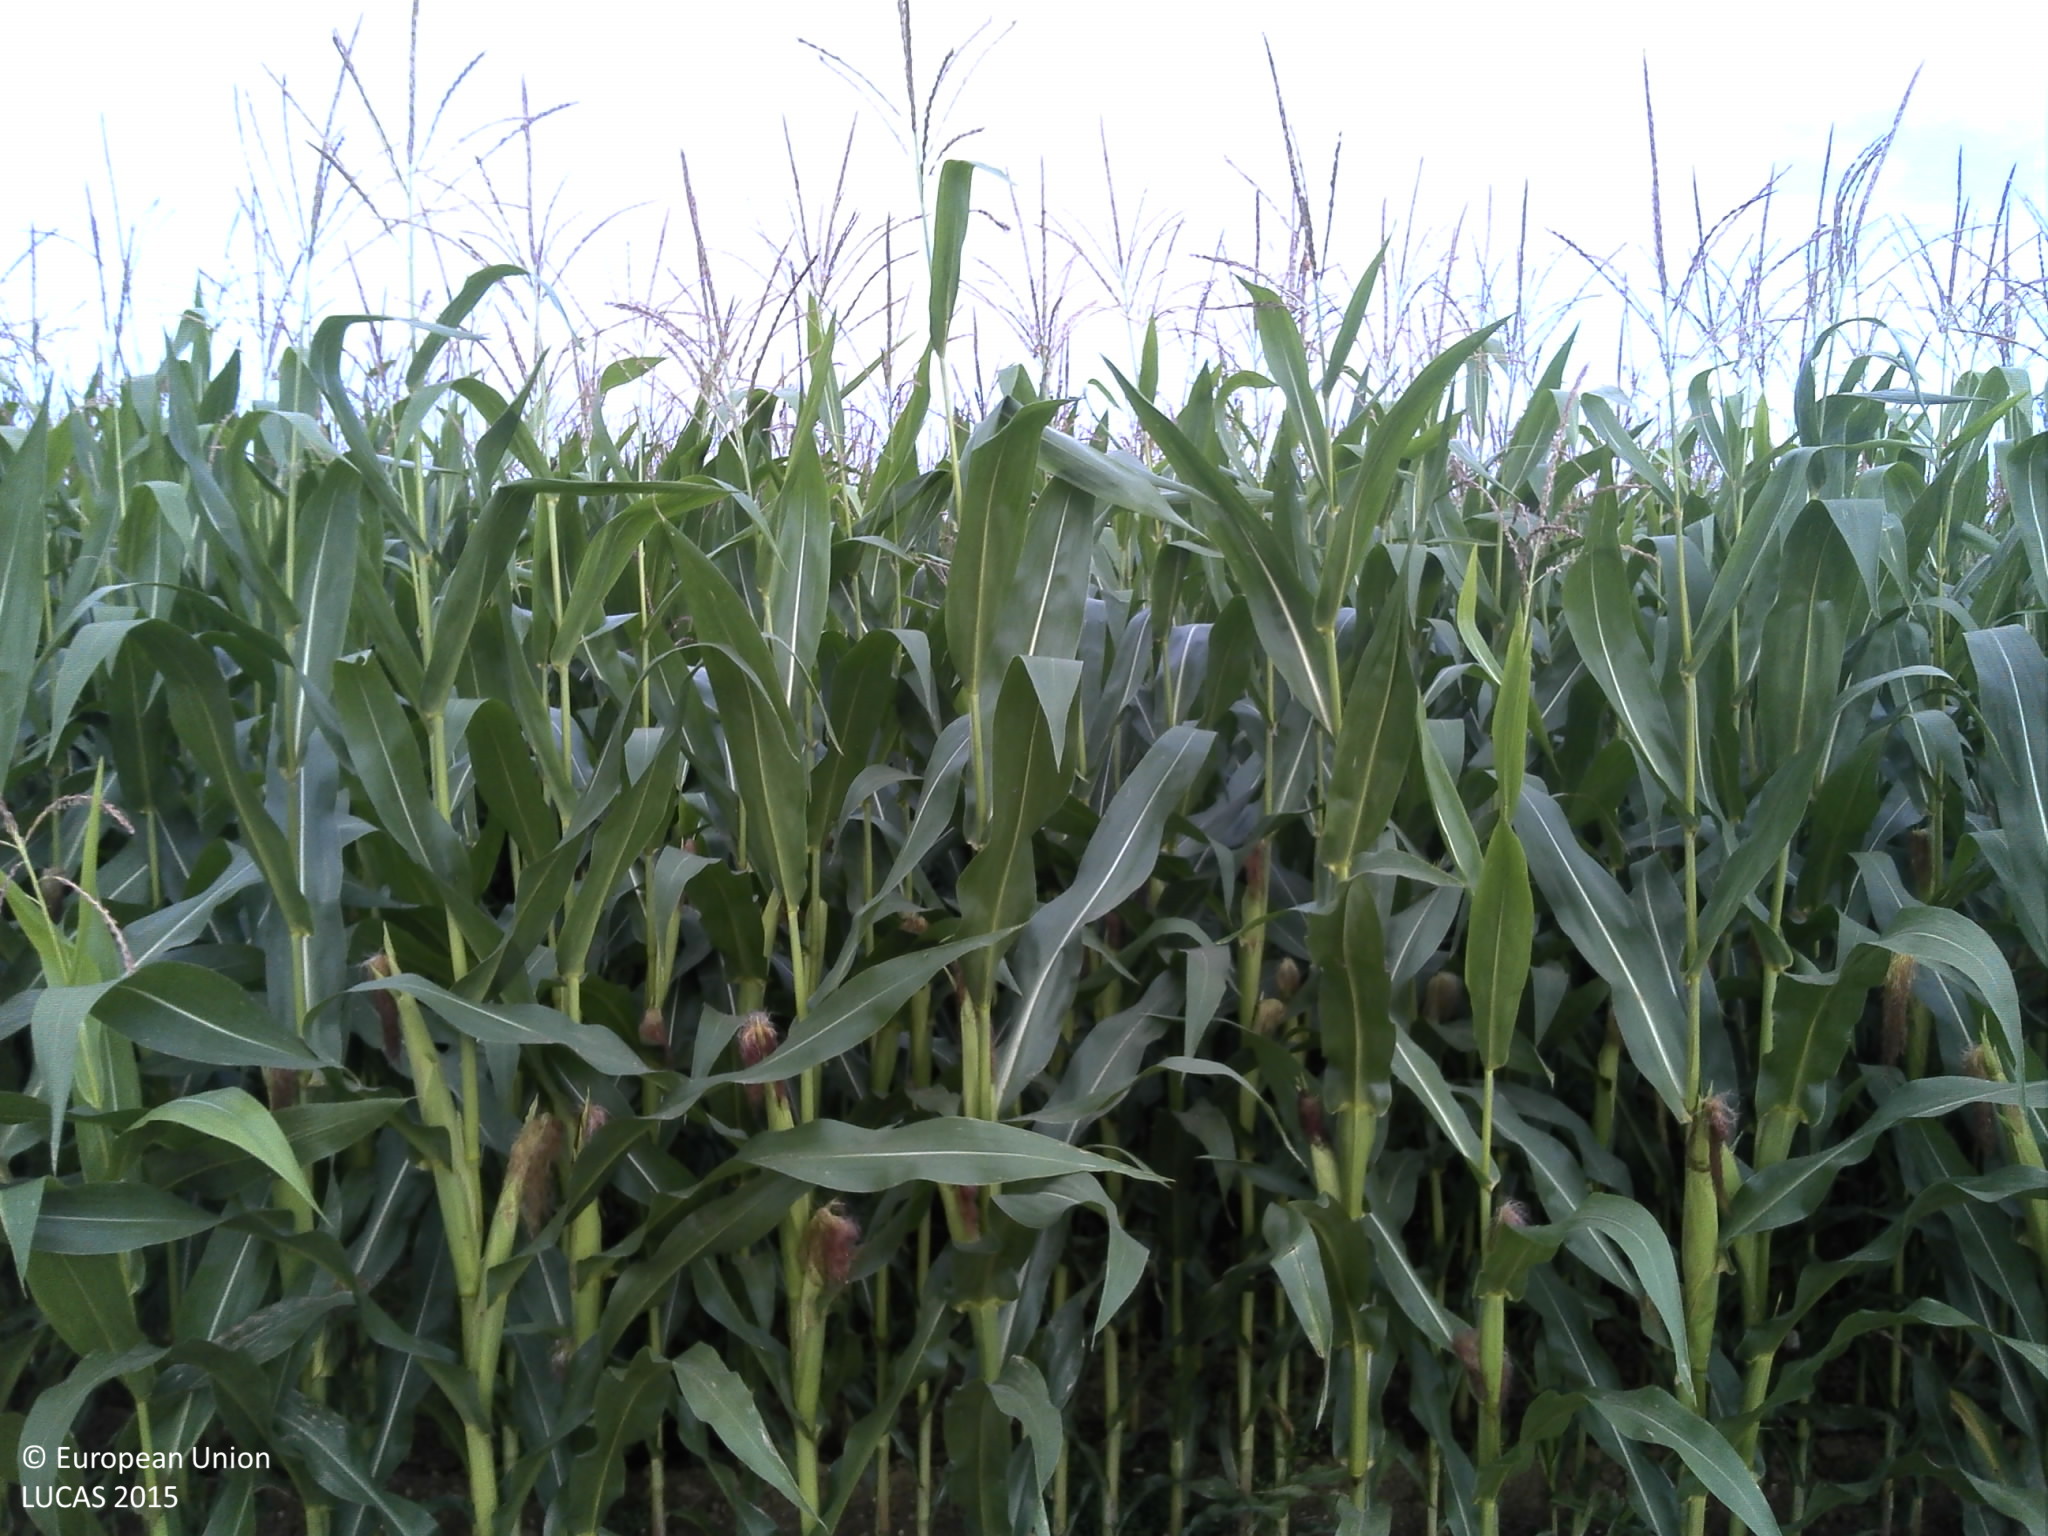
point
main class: Cropland
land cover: Maize
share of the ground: > 75 %
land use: Agriculture (excluding fallow land and kitchen gardens)
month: July
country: FR
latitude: 49.5065
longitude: 4.7907
